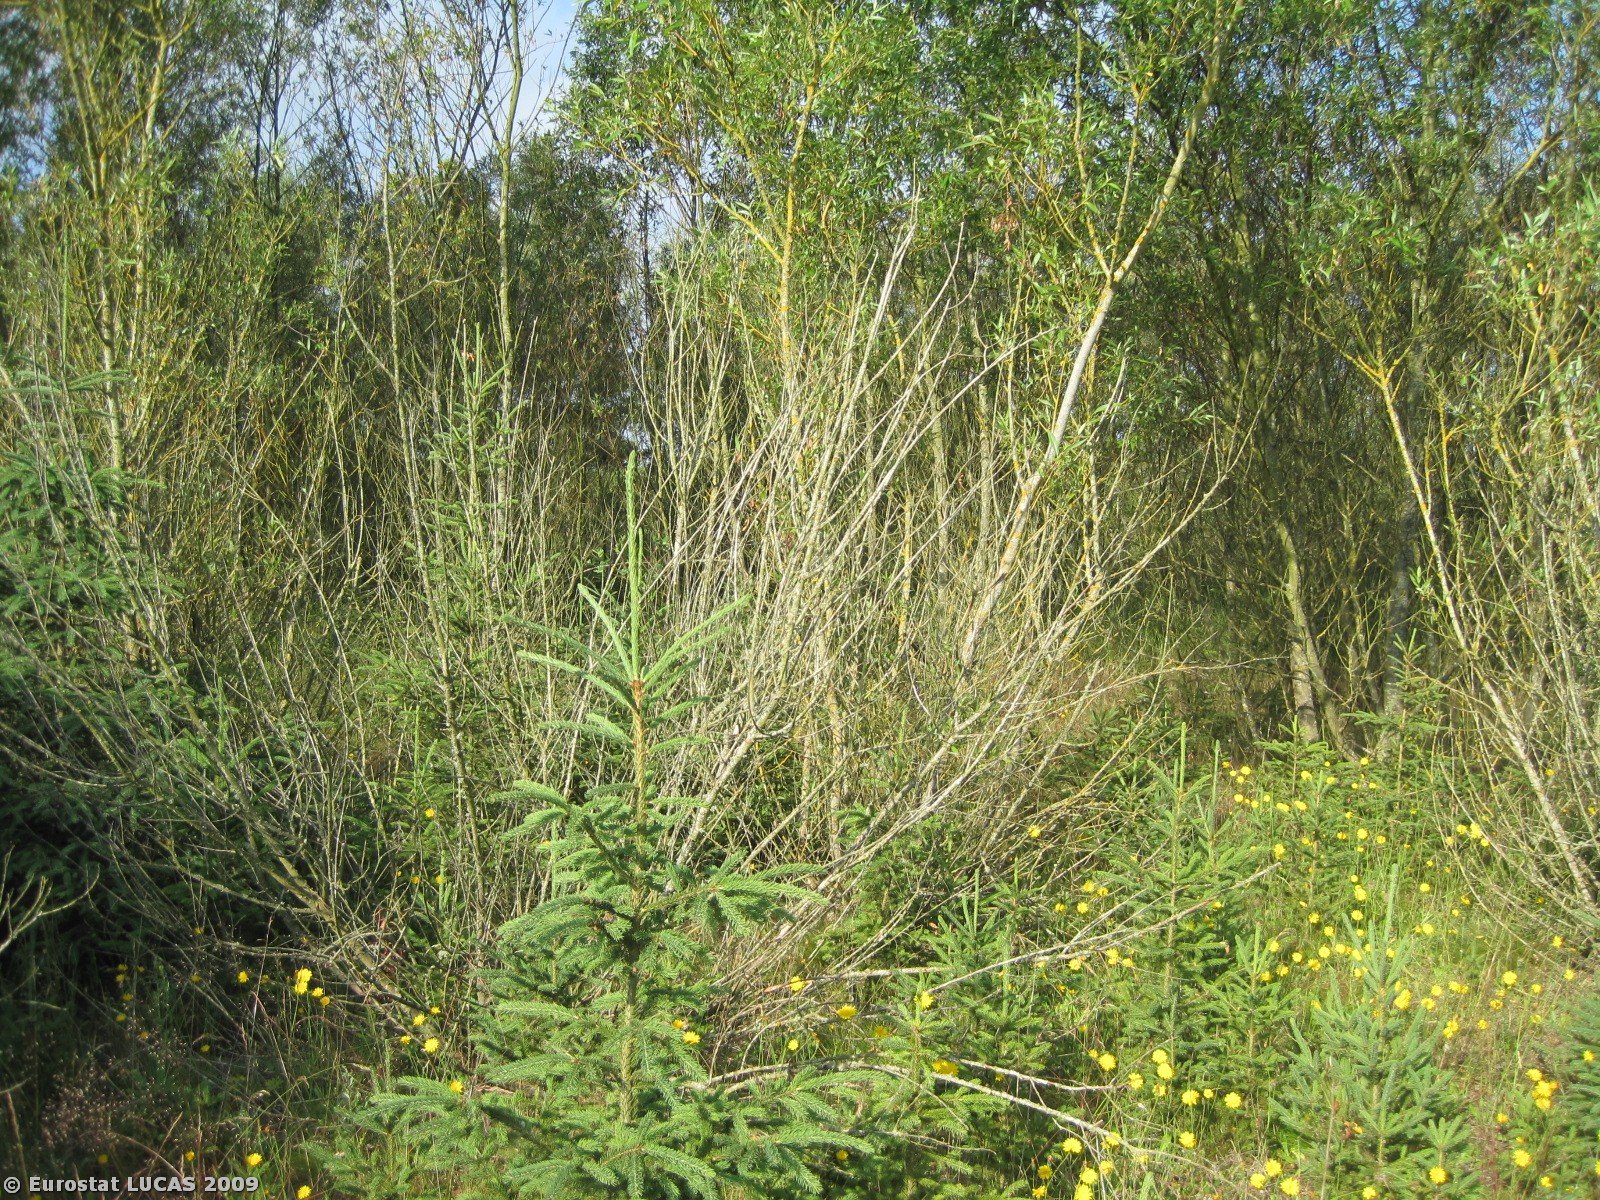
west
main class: Woodland
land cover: Mixed woodland
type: plantations and self-sown exotic forest
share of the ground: 25 - 50 %
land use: Forestry
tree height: > 5 m
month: July
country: DK
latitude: 56.4873
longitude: 8.7511
